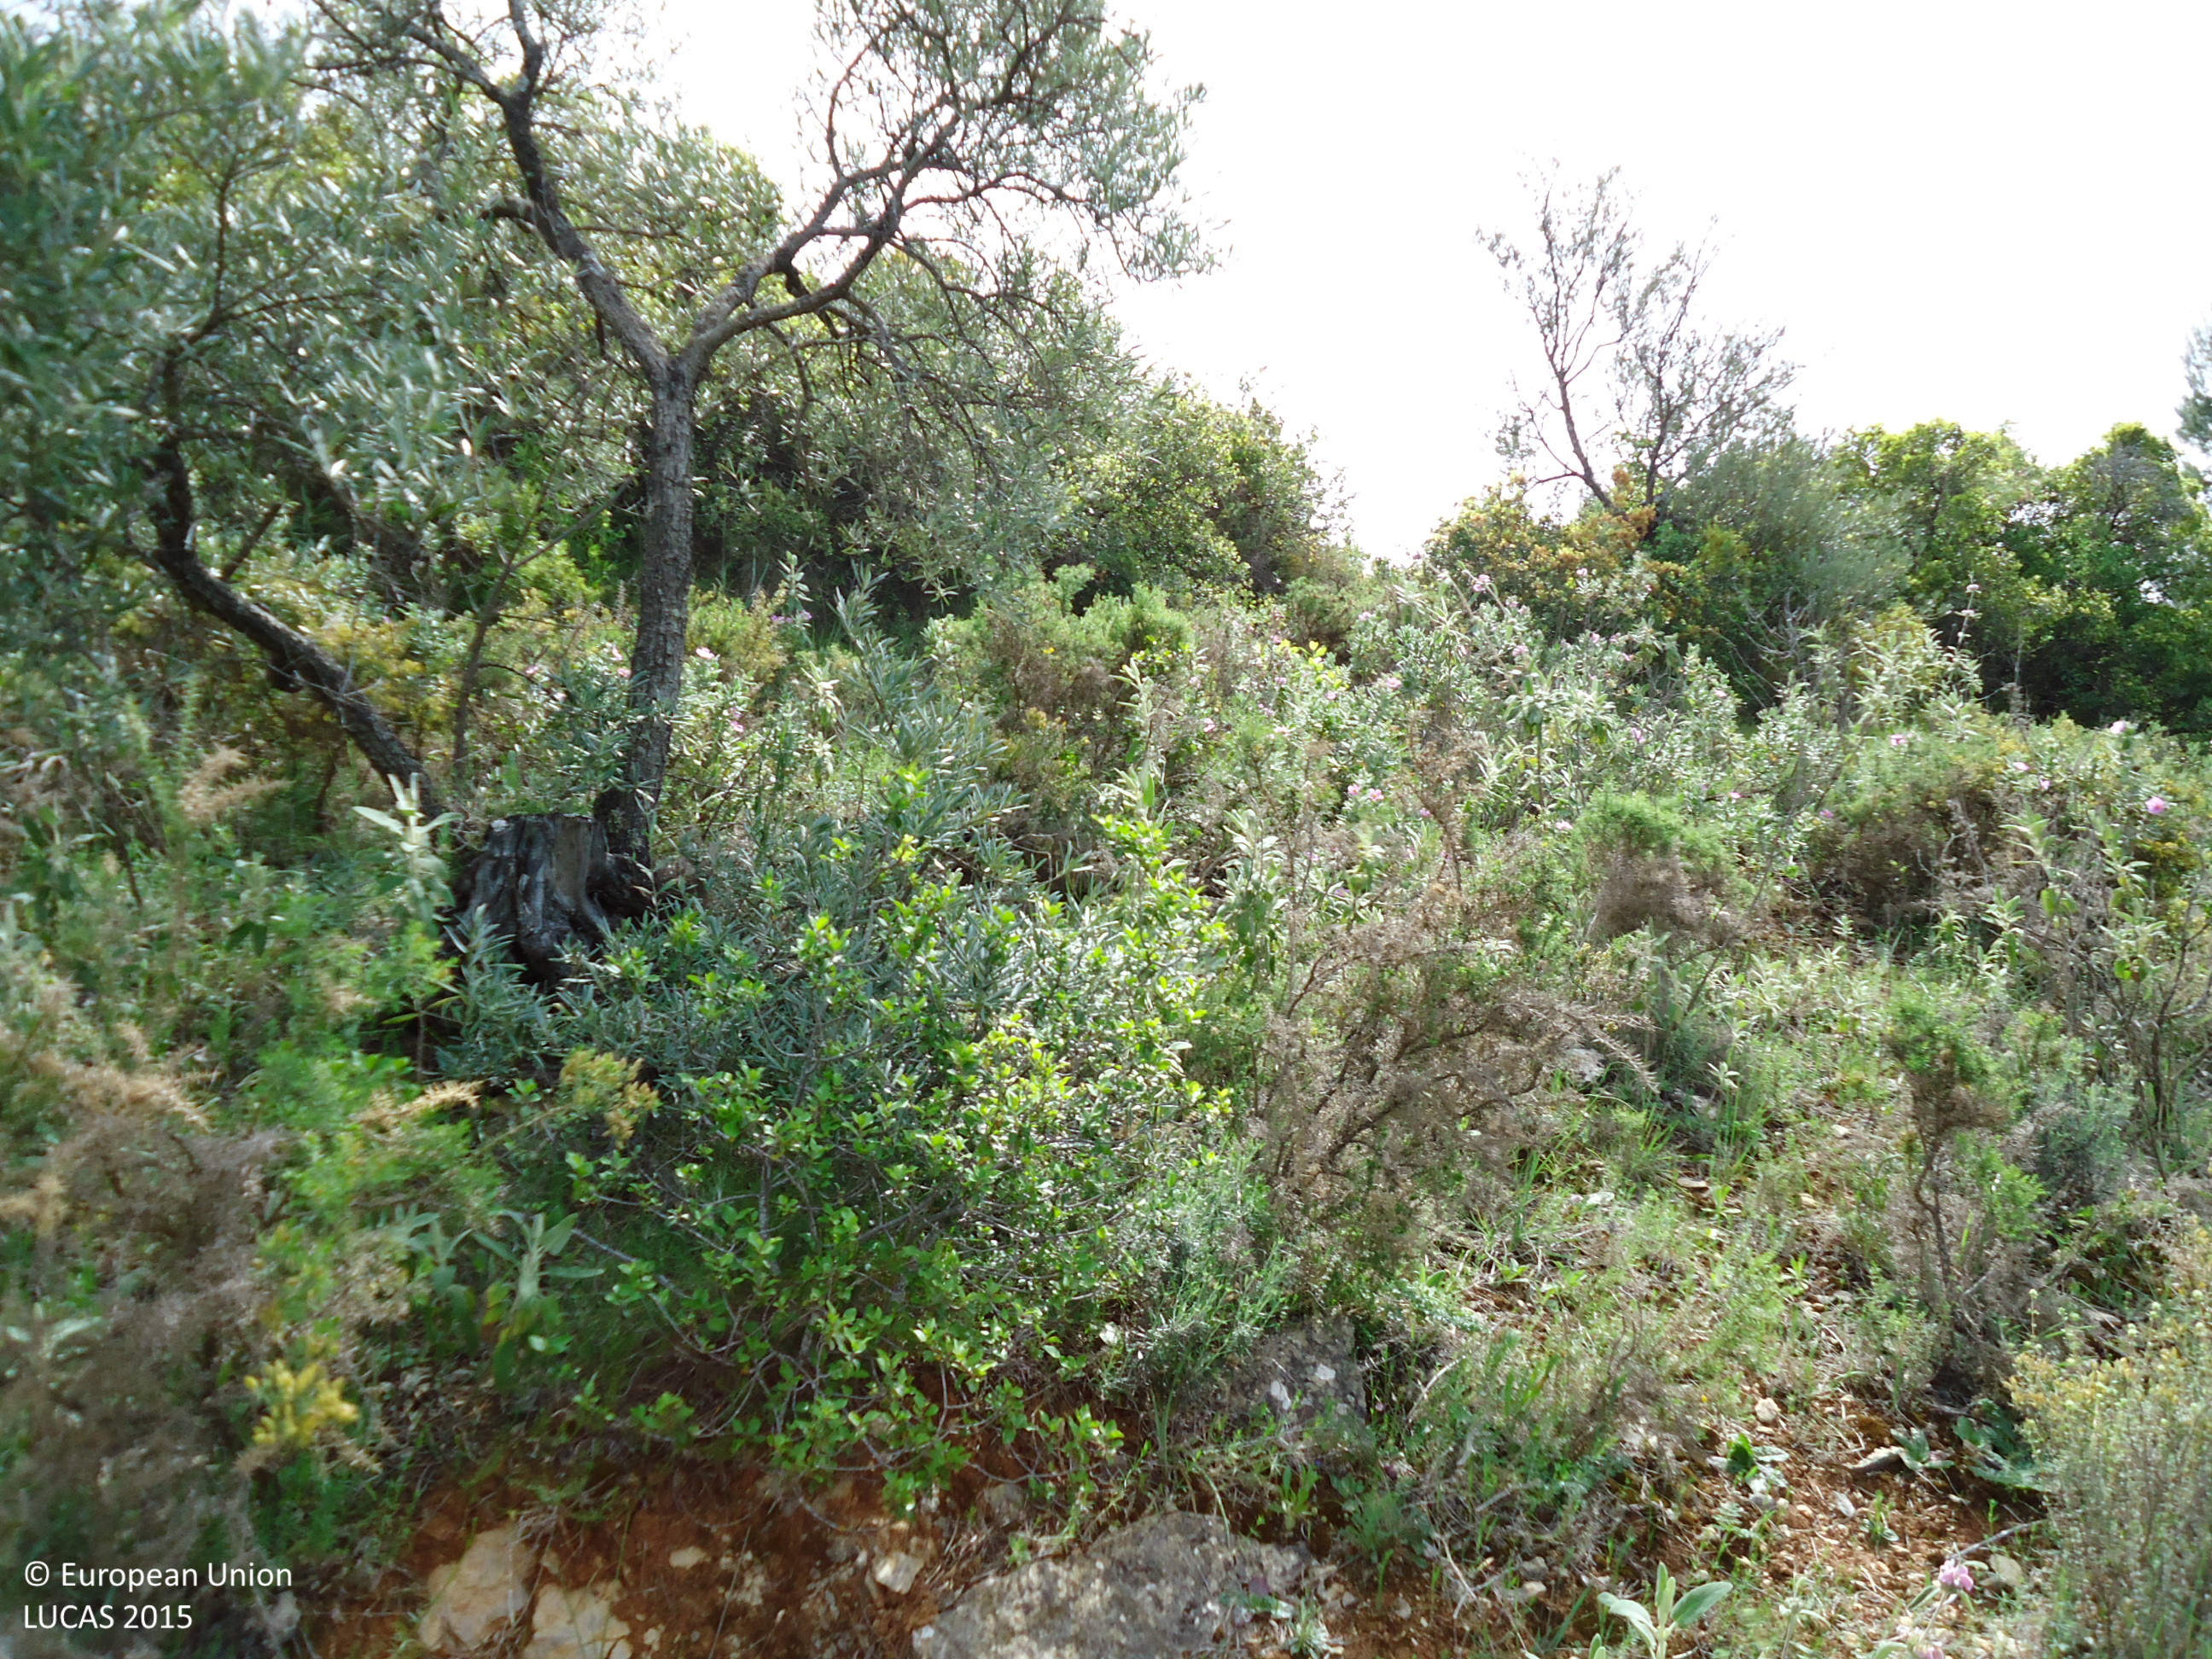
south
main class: Shrubland
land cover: Shrubland with sparse tree cover
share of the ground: > 75 %
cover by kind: shrubs 85 %, herbaceous plants 10 %, coniferous forest trees 5 %
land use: Semi-natural and natural areas not in use
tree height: > 5 m
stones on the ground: > 50 %
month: April
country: ES
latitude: 36.9025
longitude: -5.4372
